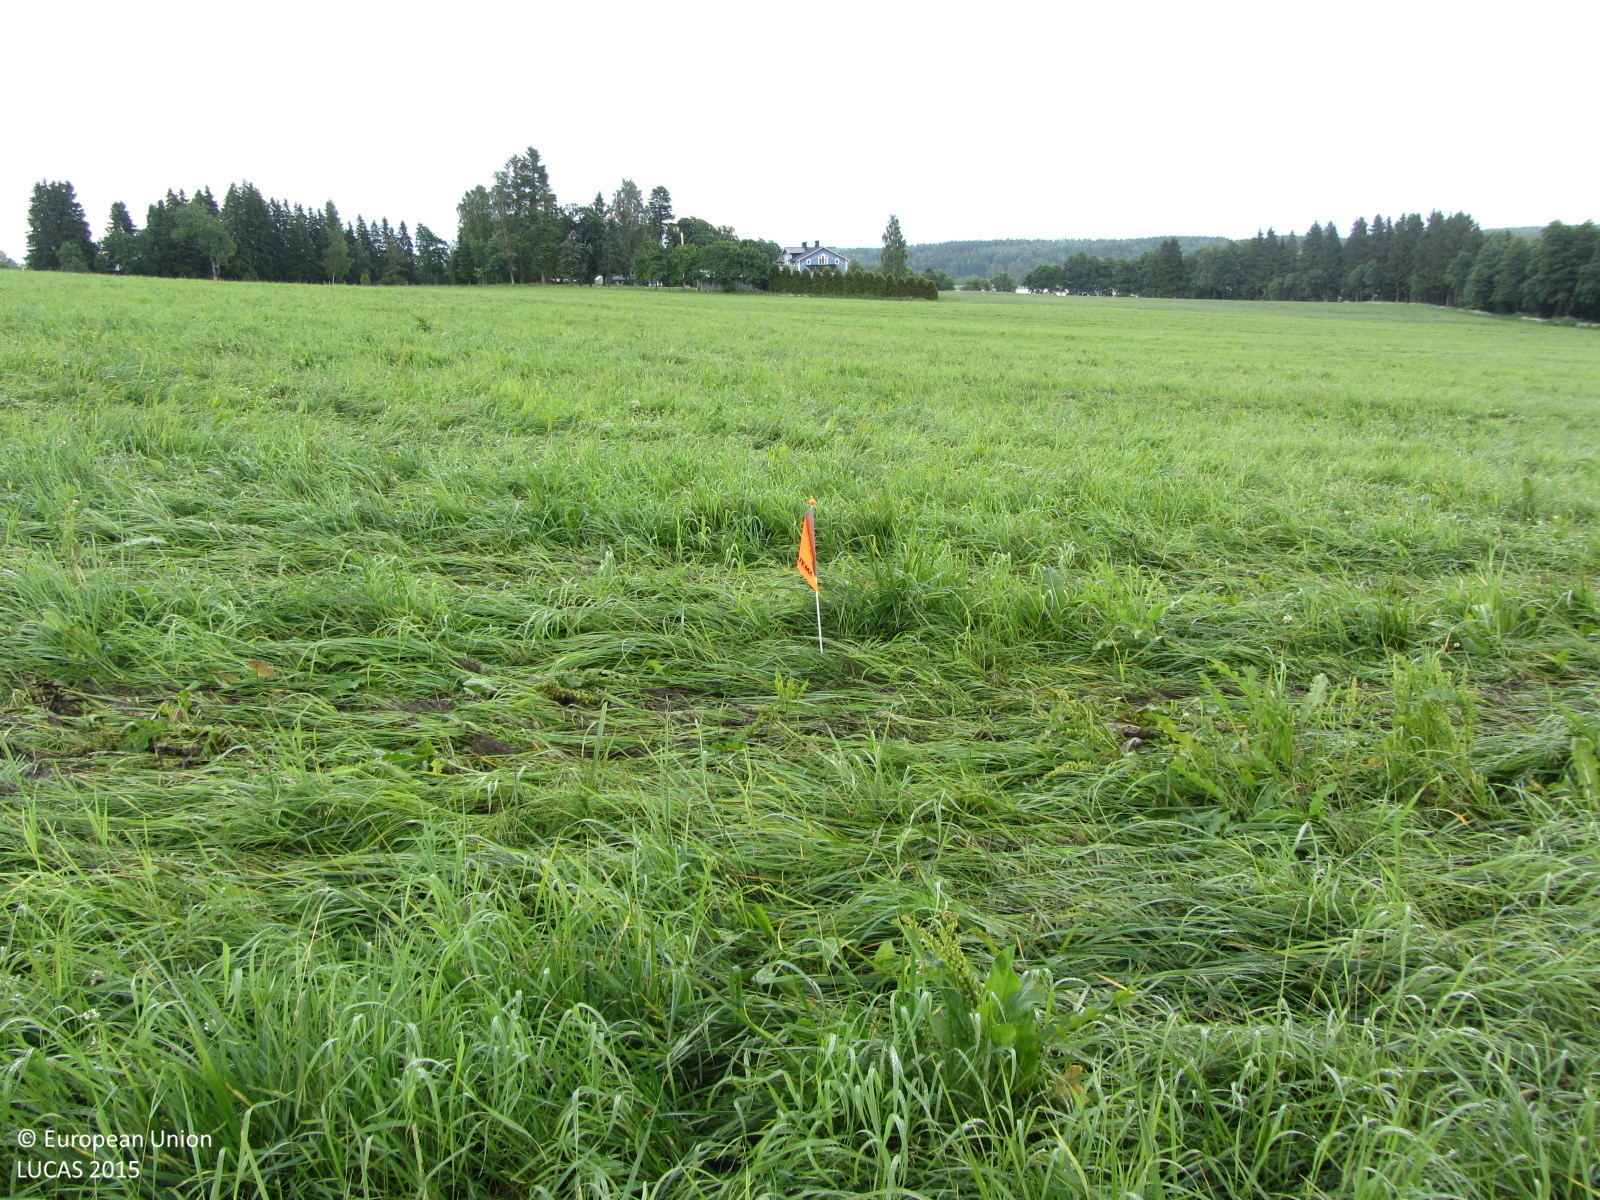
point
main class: Grassland
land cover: Grassland without tree/shrub cover
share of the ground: > 75 %
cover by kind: herbaceous plants 100 %
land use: Agriculture (excluding fallow land and kitchen gardens)
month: July
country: FI
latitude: 60.0495
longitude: 23.2111
